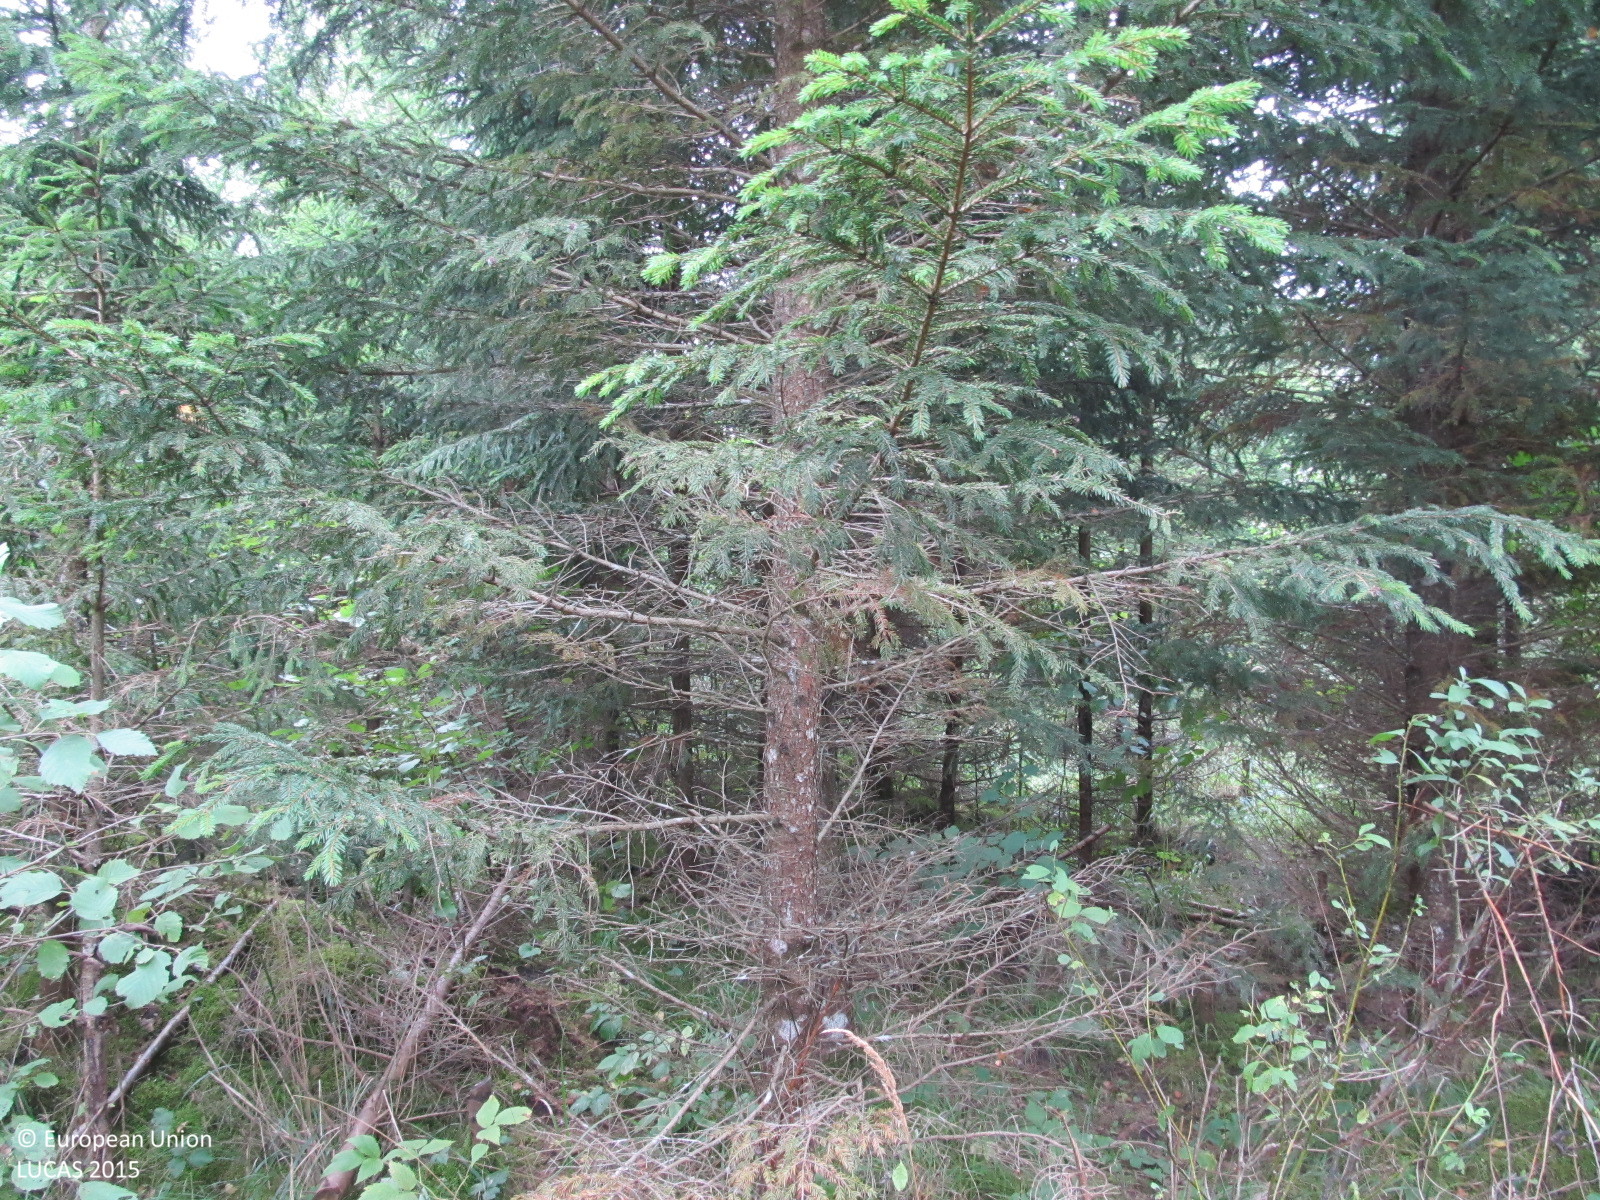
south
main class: Woodland
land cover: Spruce dominated mixed woodland
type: hemiboreal forest and nemoral coniferous forest and mixed broadleaved-coniferous forest
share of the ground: > 75 %
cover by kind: coniferous forest trees 50 %, broadleaved forest trees 30 %, shrubs 10 %, herbaceous plants 5 %, lichens and mosses 5 %
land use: Forestry
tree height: > 5 m
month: September
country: LT
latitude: 56.2862
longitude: 23.2040
